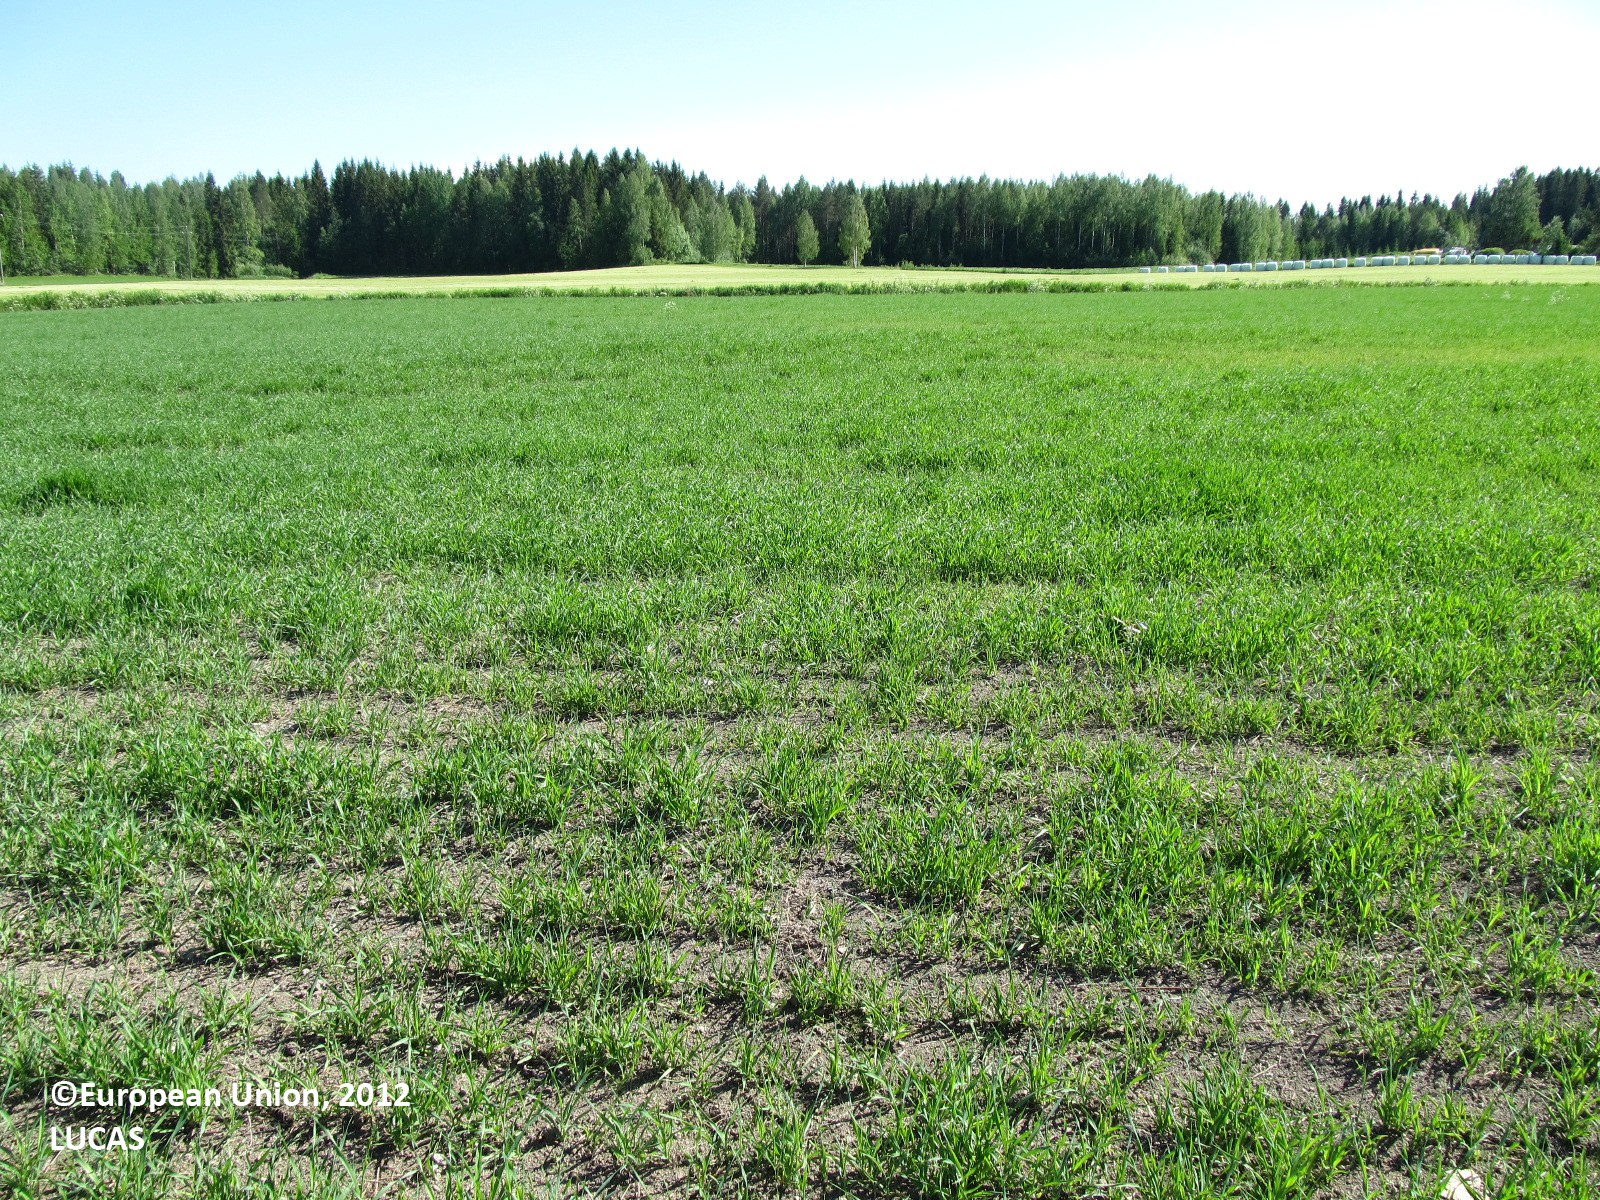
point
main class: Cropland
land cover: Barley
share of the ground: 25 - 50 %
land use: Agriculture (excluding fallow land and kitchen gardens)
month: June
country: FI
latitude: 63.0194
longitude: 27.5286
